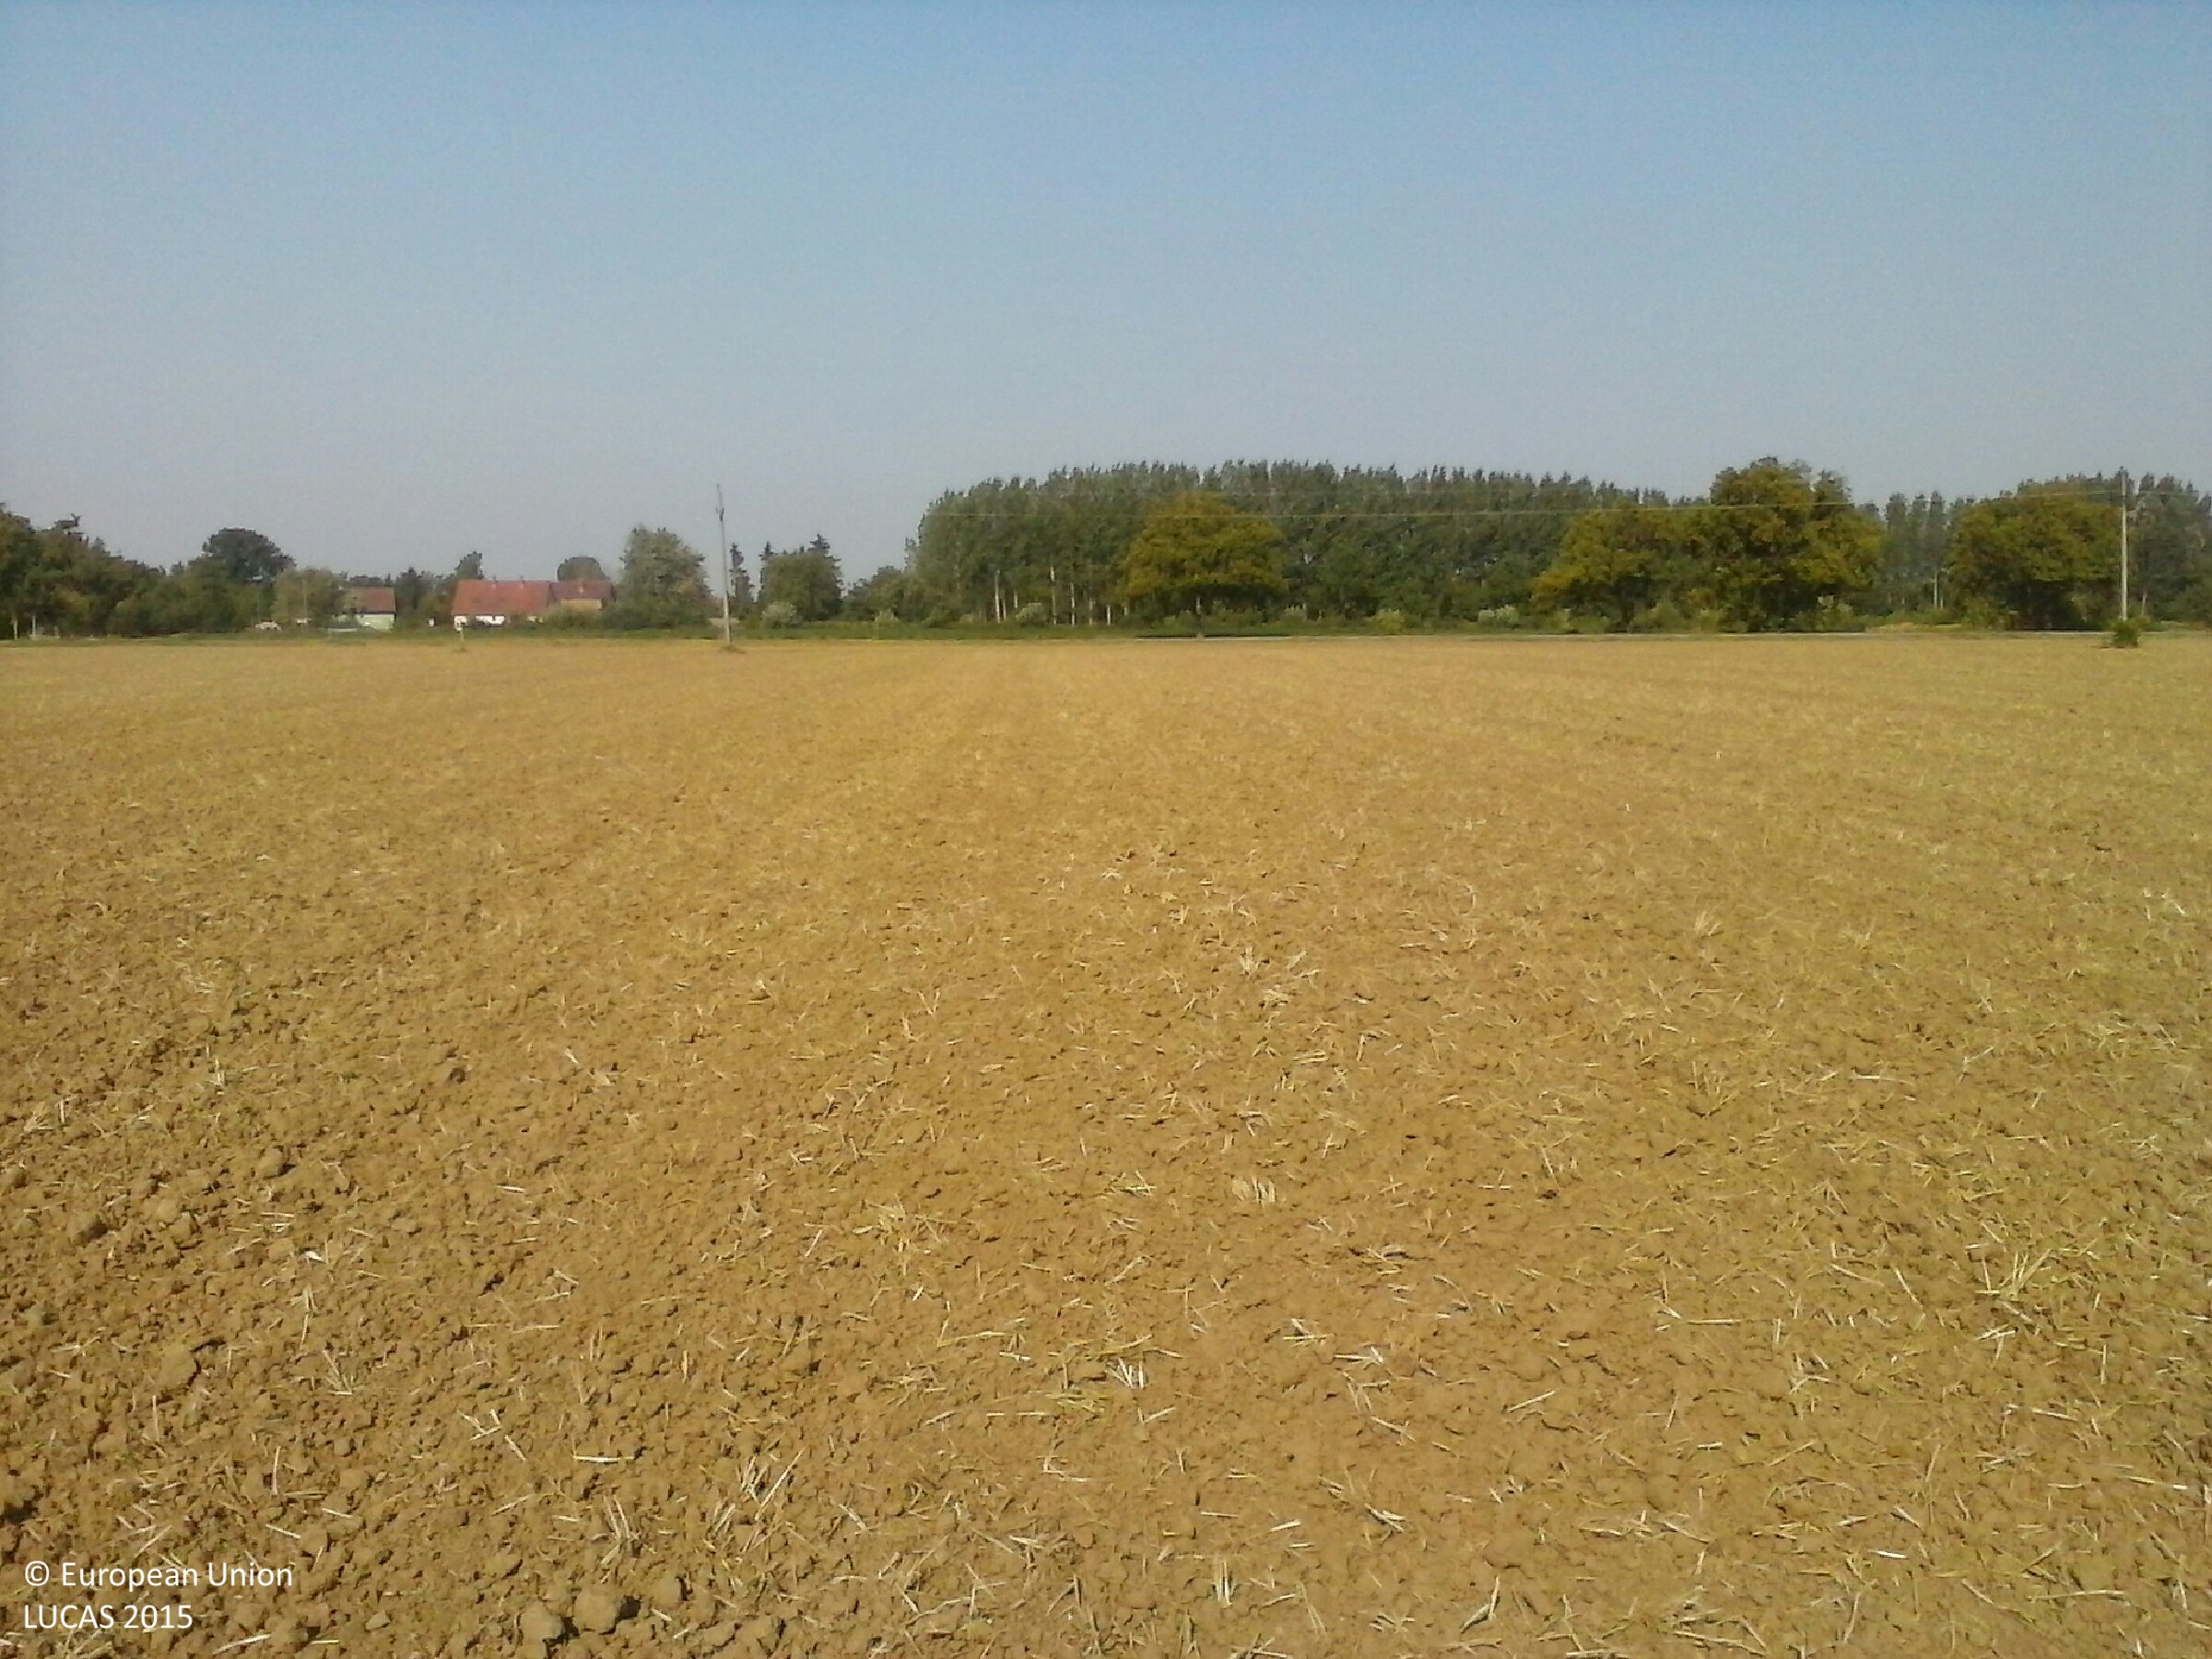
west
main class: Cropland
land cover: Common wheat
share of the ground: < 10 %
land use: Agriculture (excluding fallow land and kitchen gardens)
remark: Harvested field
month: August
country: HU
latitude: 46.0227
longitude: 17.8979
